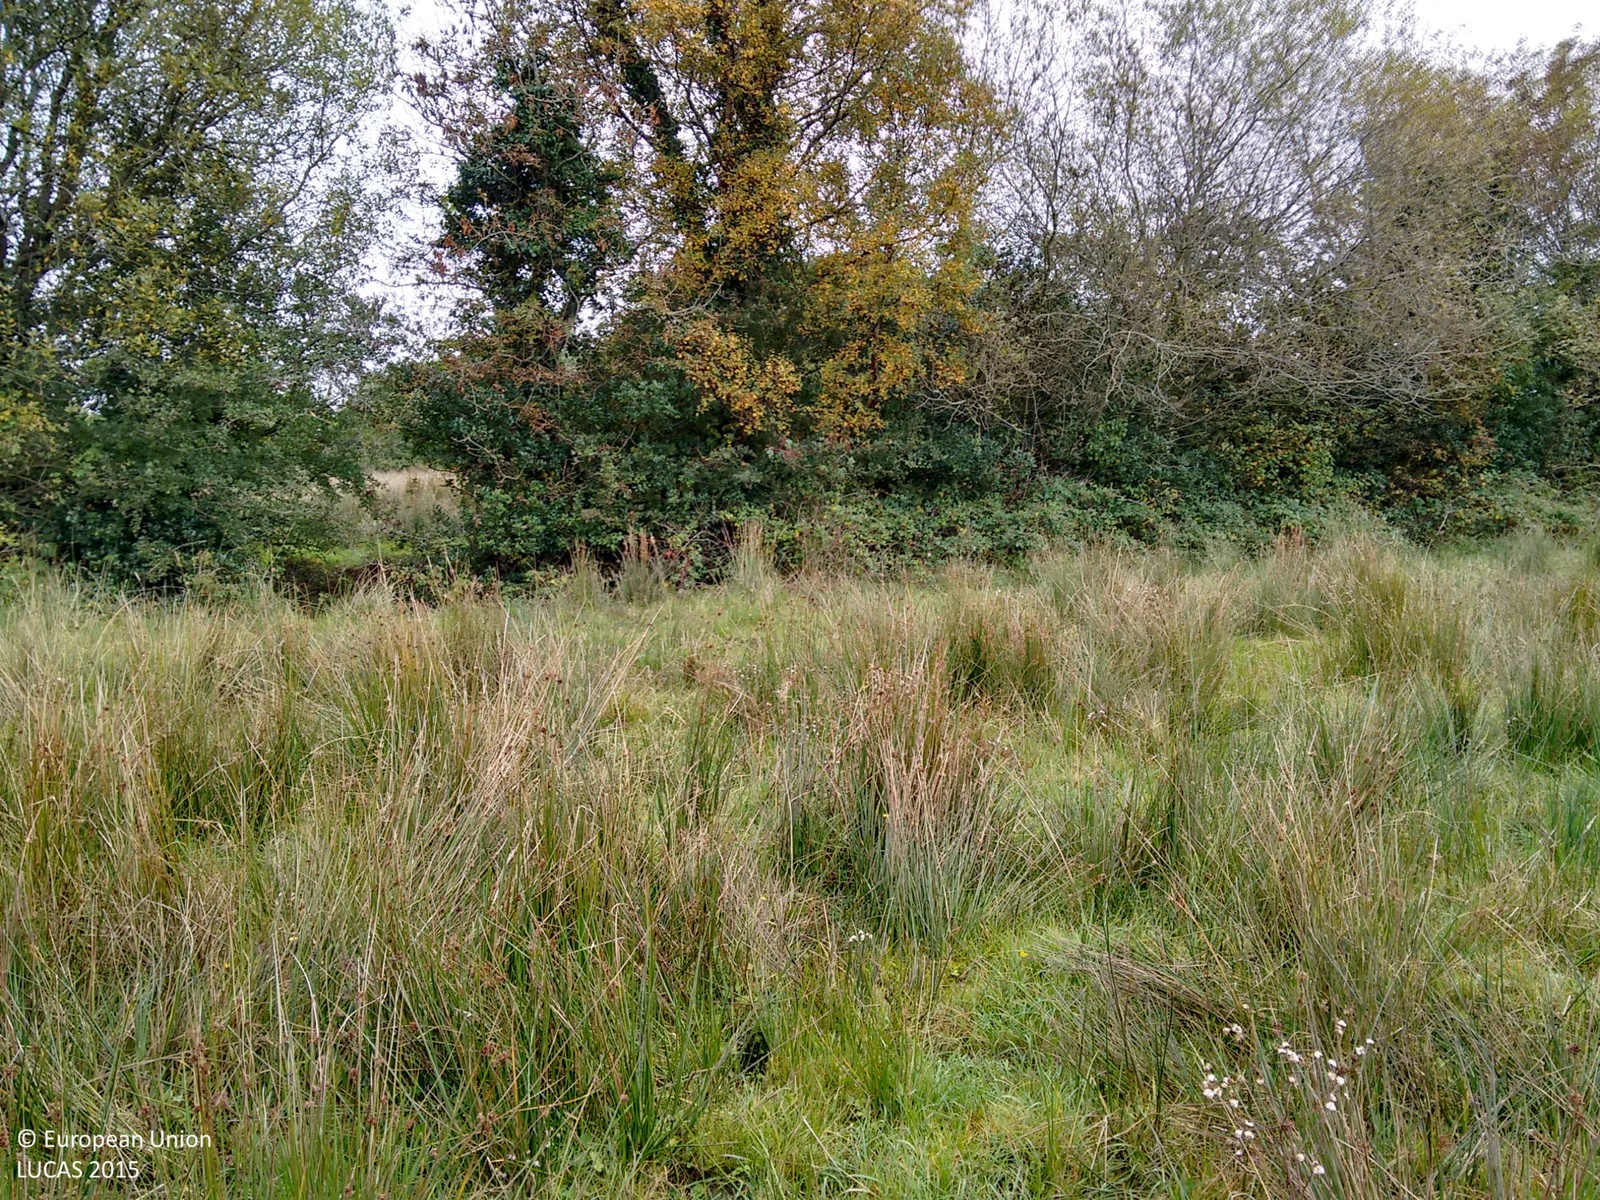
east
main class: Grassland
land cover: Grassland without tree/shrub cover
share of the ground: > 75 %
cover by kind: herbaceous plants 100 %
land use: Agriculture (excluding fallow land and kitchen gardens)
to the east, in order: Grassland without tree/shrub cover; Ditches and canals; Abandoned hedges; Grassland without tree/shrub cover; Fences; Grass margins; Ditches and canals; Broadleaved woodland; Fences; Grassland without tree/shrub cover
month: October
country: GB
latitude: 54.5132
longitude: -7.8539
